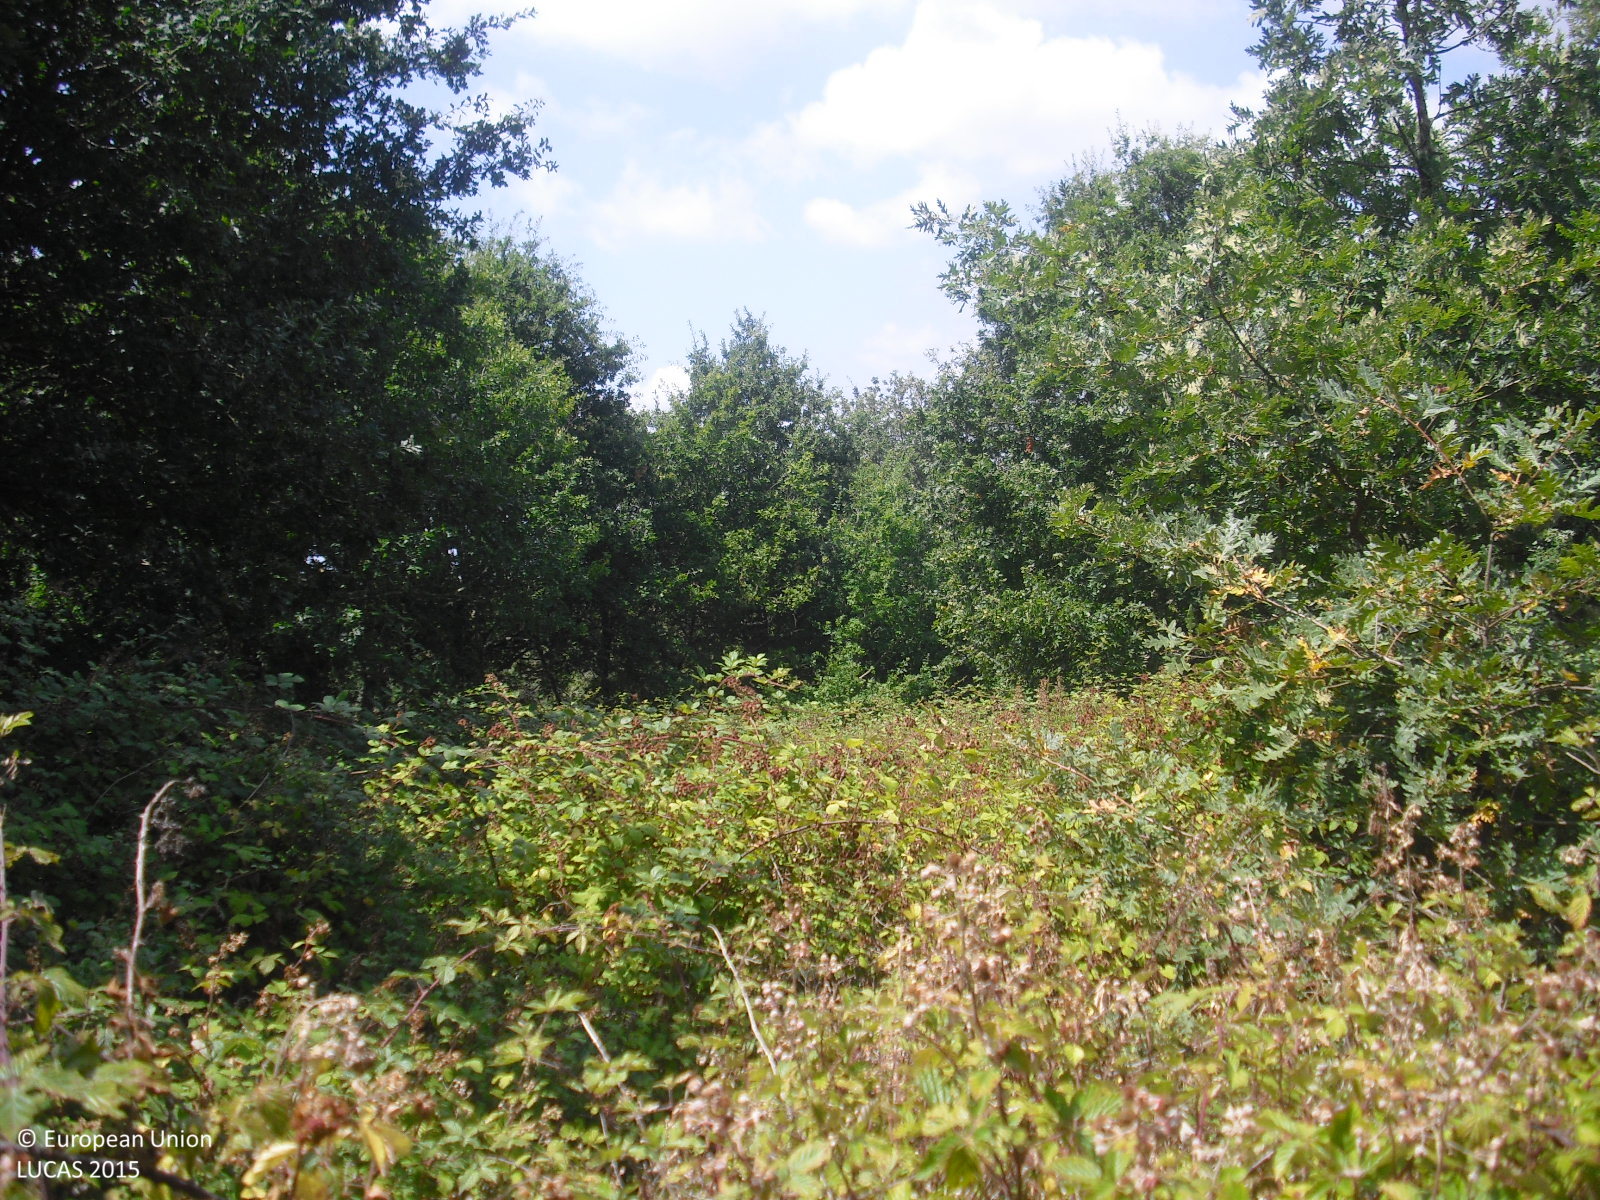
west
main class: Woodland
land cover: Broadleaved woodland
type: thermophilous deciduous forest
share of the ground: 25 - 50 %
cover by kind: shrubs 60 %, broadleaved forest trees 30 %, herbaceous plants 10 %
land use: Semi-natural and natural areas not in use
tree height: > 5 m
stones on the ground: < 10 %
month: July
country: ES
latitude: 42.3509
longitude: -7.7120
